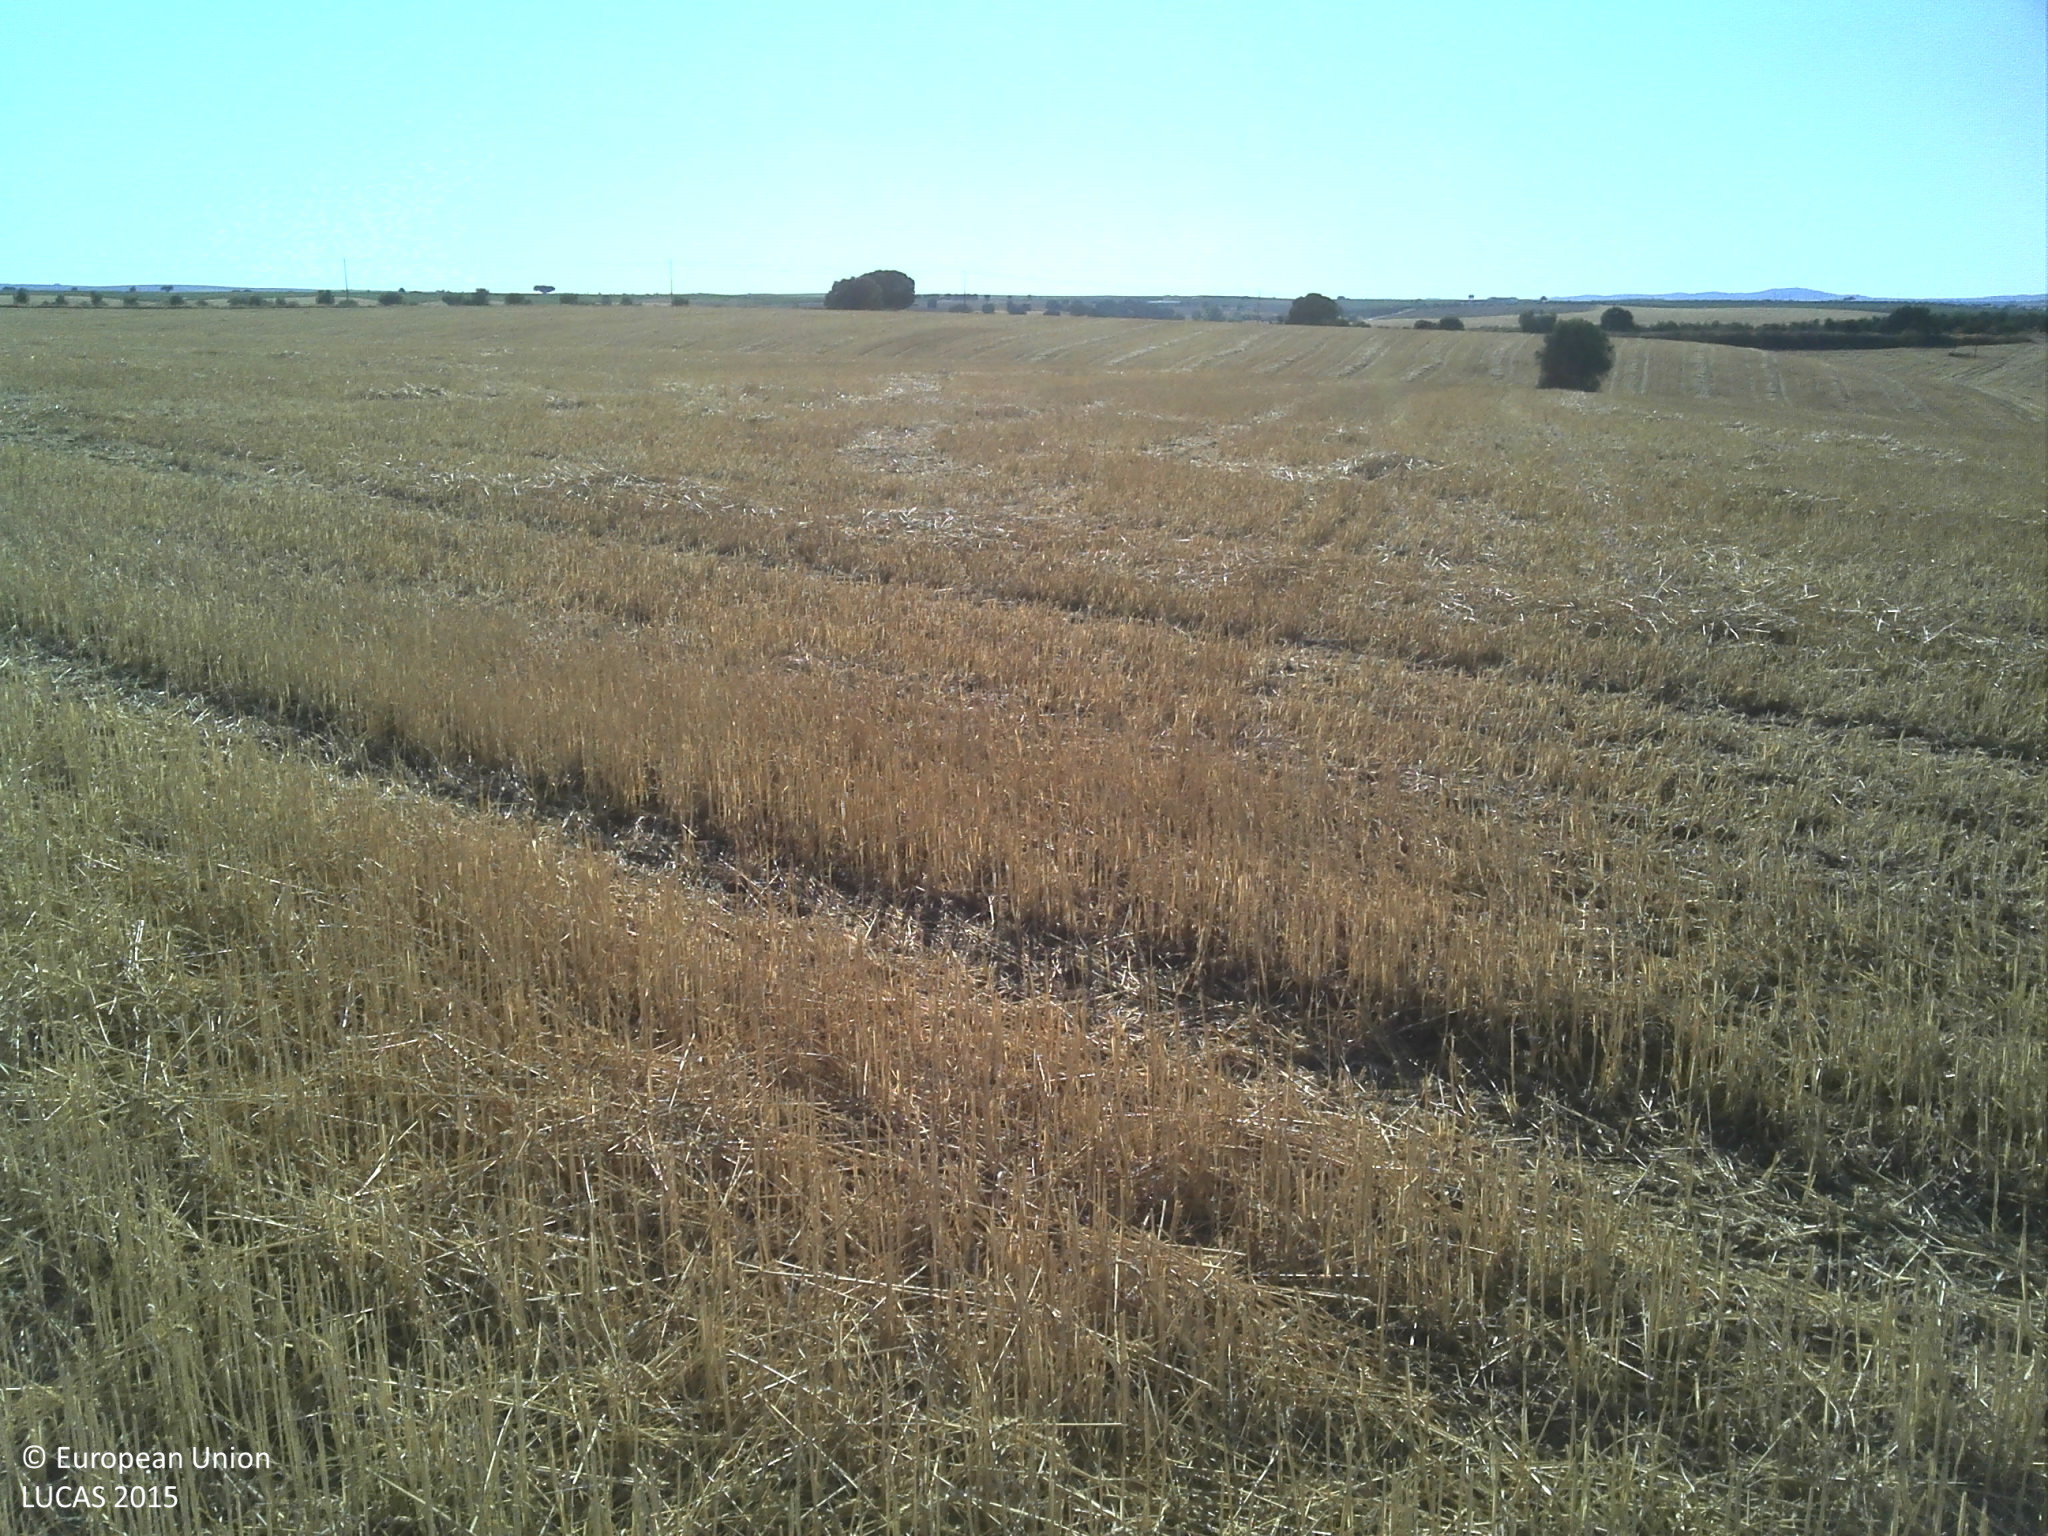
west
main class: Cropland
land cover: Common wheat
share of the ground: 25 - 50 %
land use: Agriculture (excluding fallow land and kitchen gardens)
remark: Harvested field
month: July
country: PT
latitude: 38.1351
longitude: -7.6520
